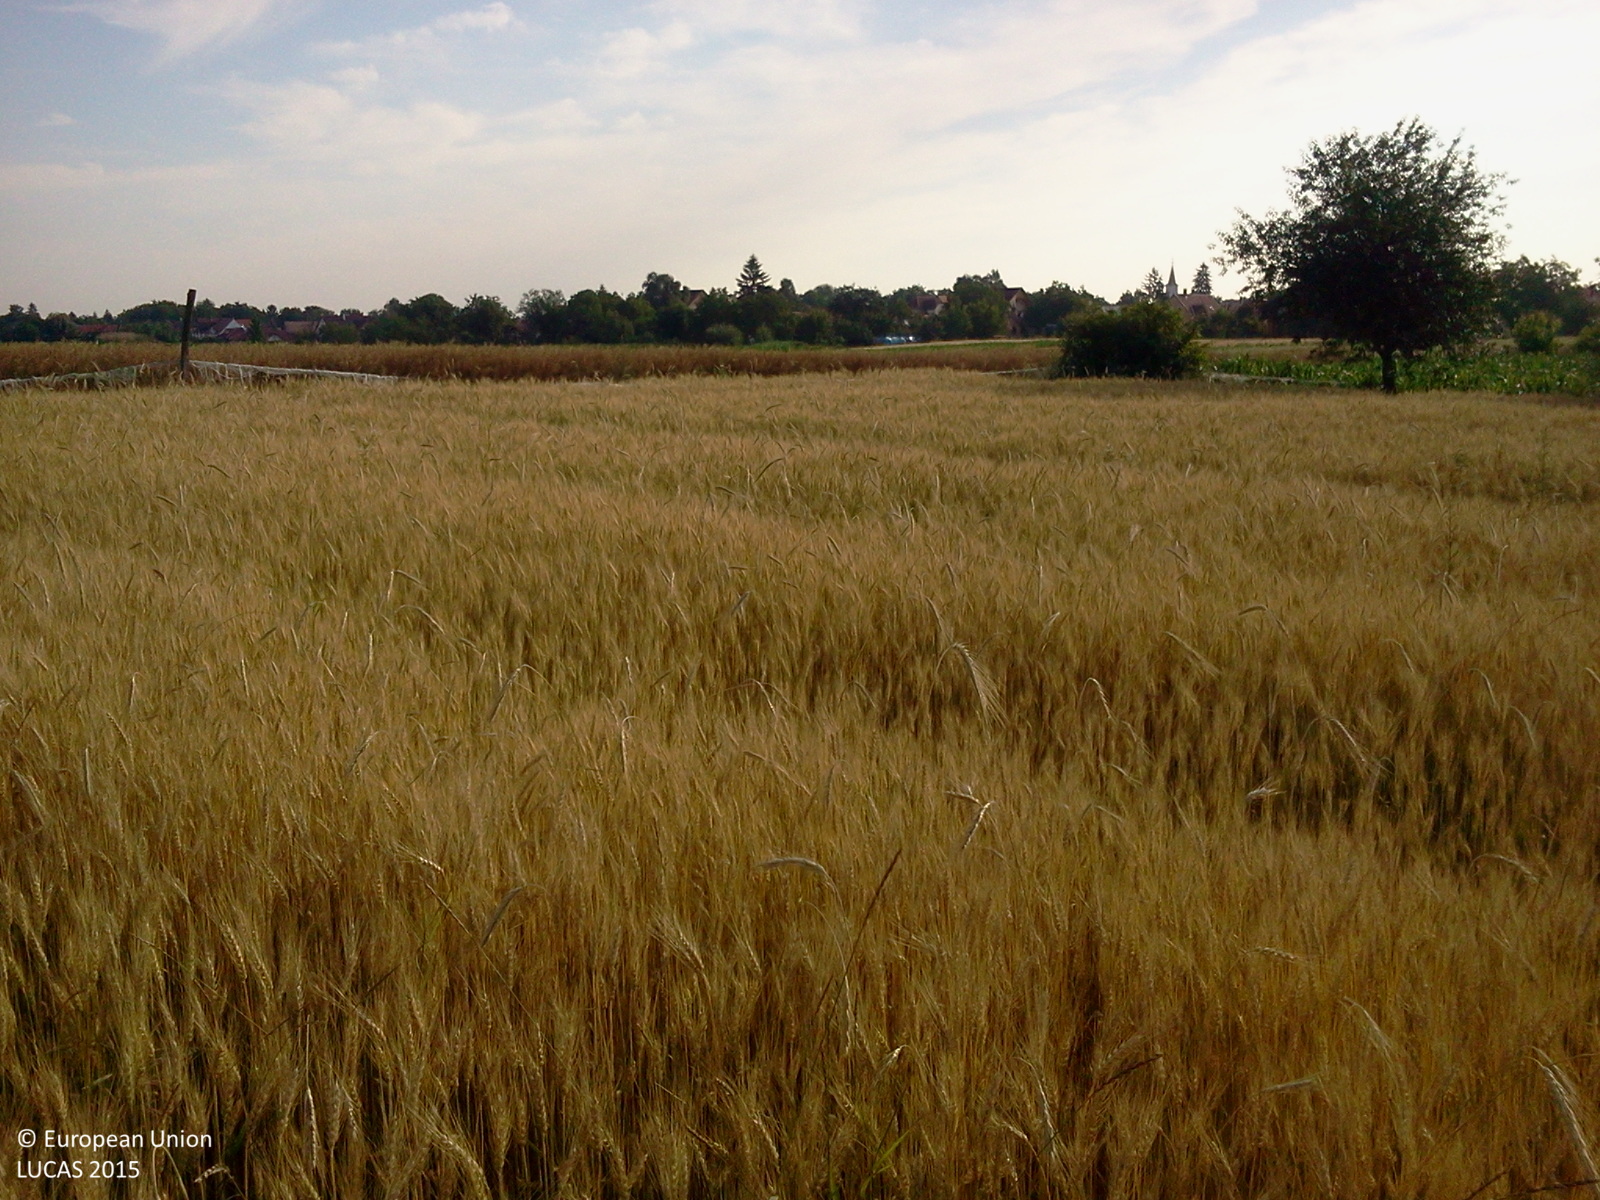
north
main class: Cropland
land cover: Durum wheat
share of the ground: > 75 %
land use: Agriculture (excluding fallow land and kitchen gardens)
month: June
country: HU
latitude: 46.7180
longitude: 17.0027
